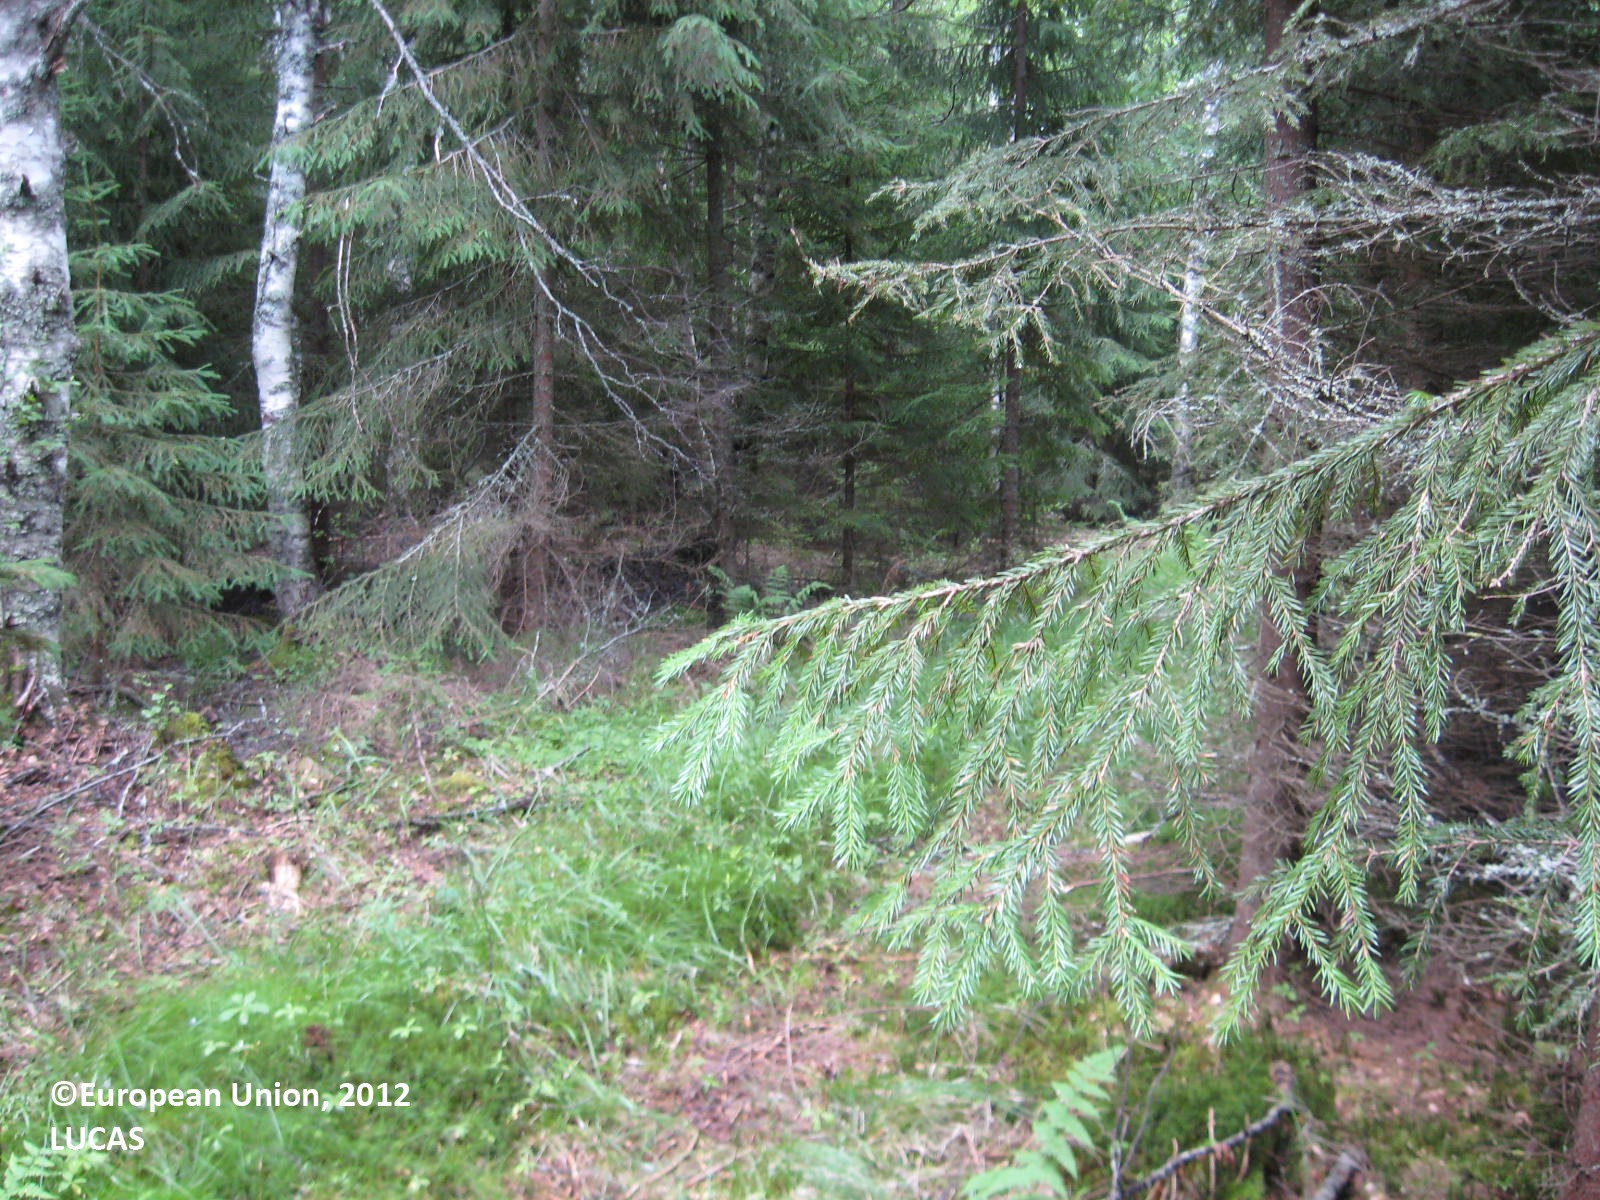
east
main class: Woodland
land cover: Spruce dominated mixed woodland
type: boreal forest
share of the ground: > 75 %
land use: Forestry
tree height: > 5 m
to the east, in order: Spruce dominated mixed woodland; Tracks; Spruce dominated mixed woodland; Shruby margins; Ditches and canals; Pine dominated mixed woodland; Ditches and canals; Pine dominated mixed woodland; Ditches and canals; Shrubland without tree cover; Ditches and canals; Shrubland without tree cover; Ditches and canals; Shrubland without tree cover
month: July
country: FI
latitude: 62.3529
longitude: 21.4997
